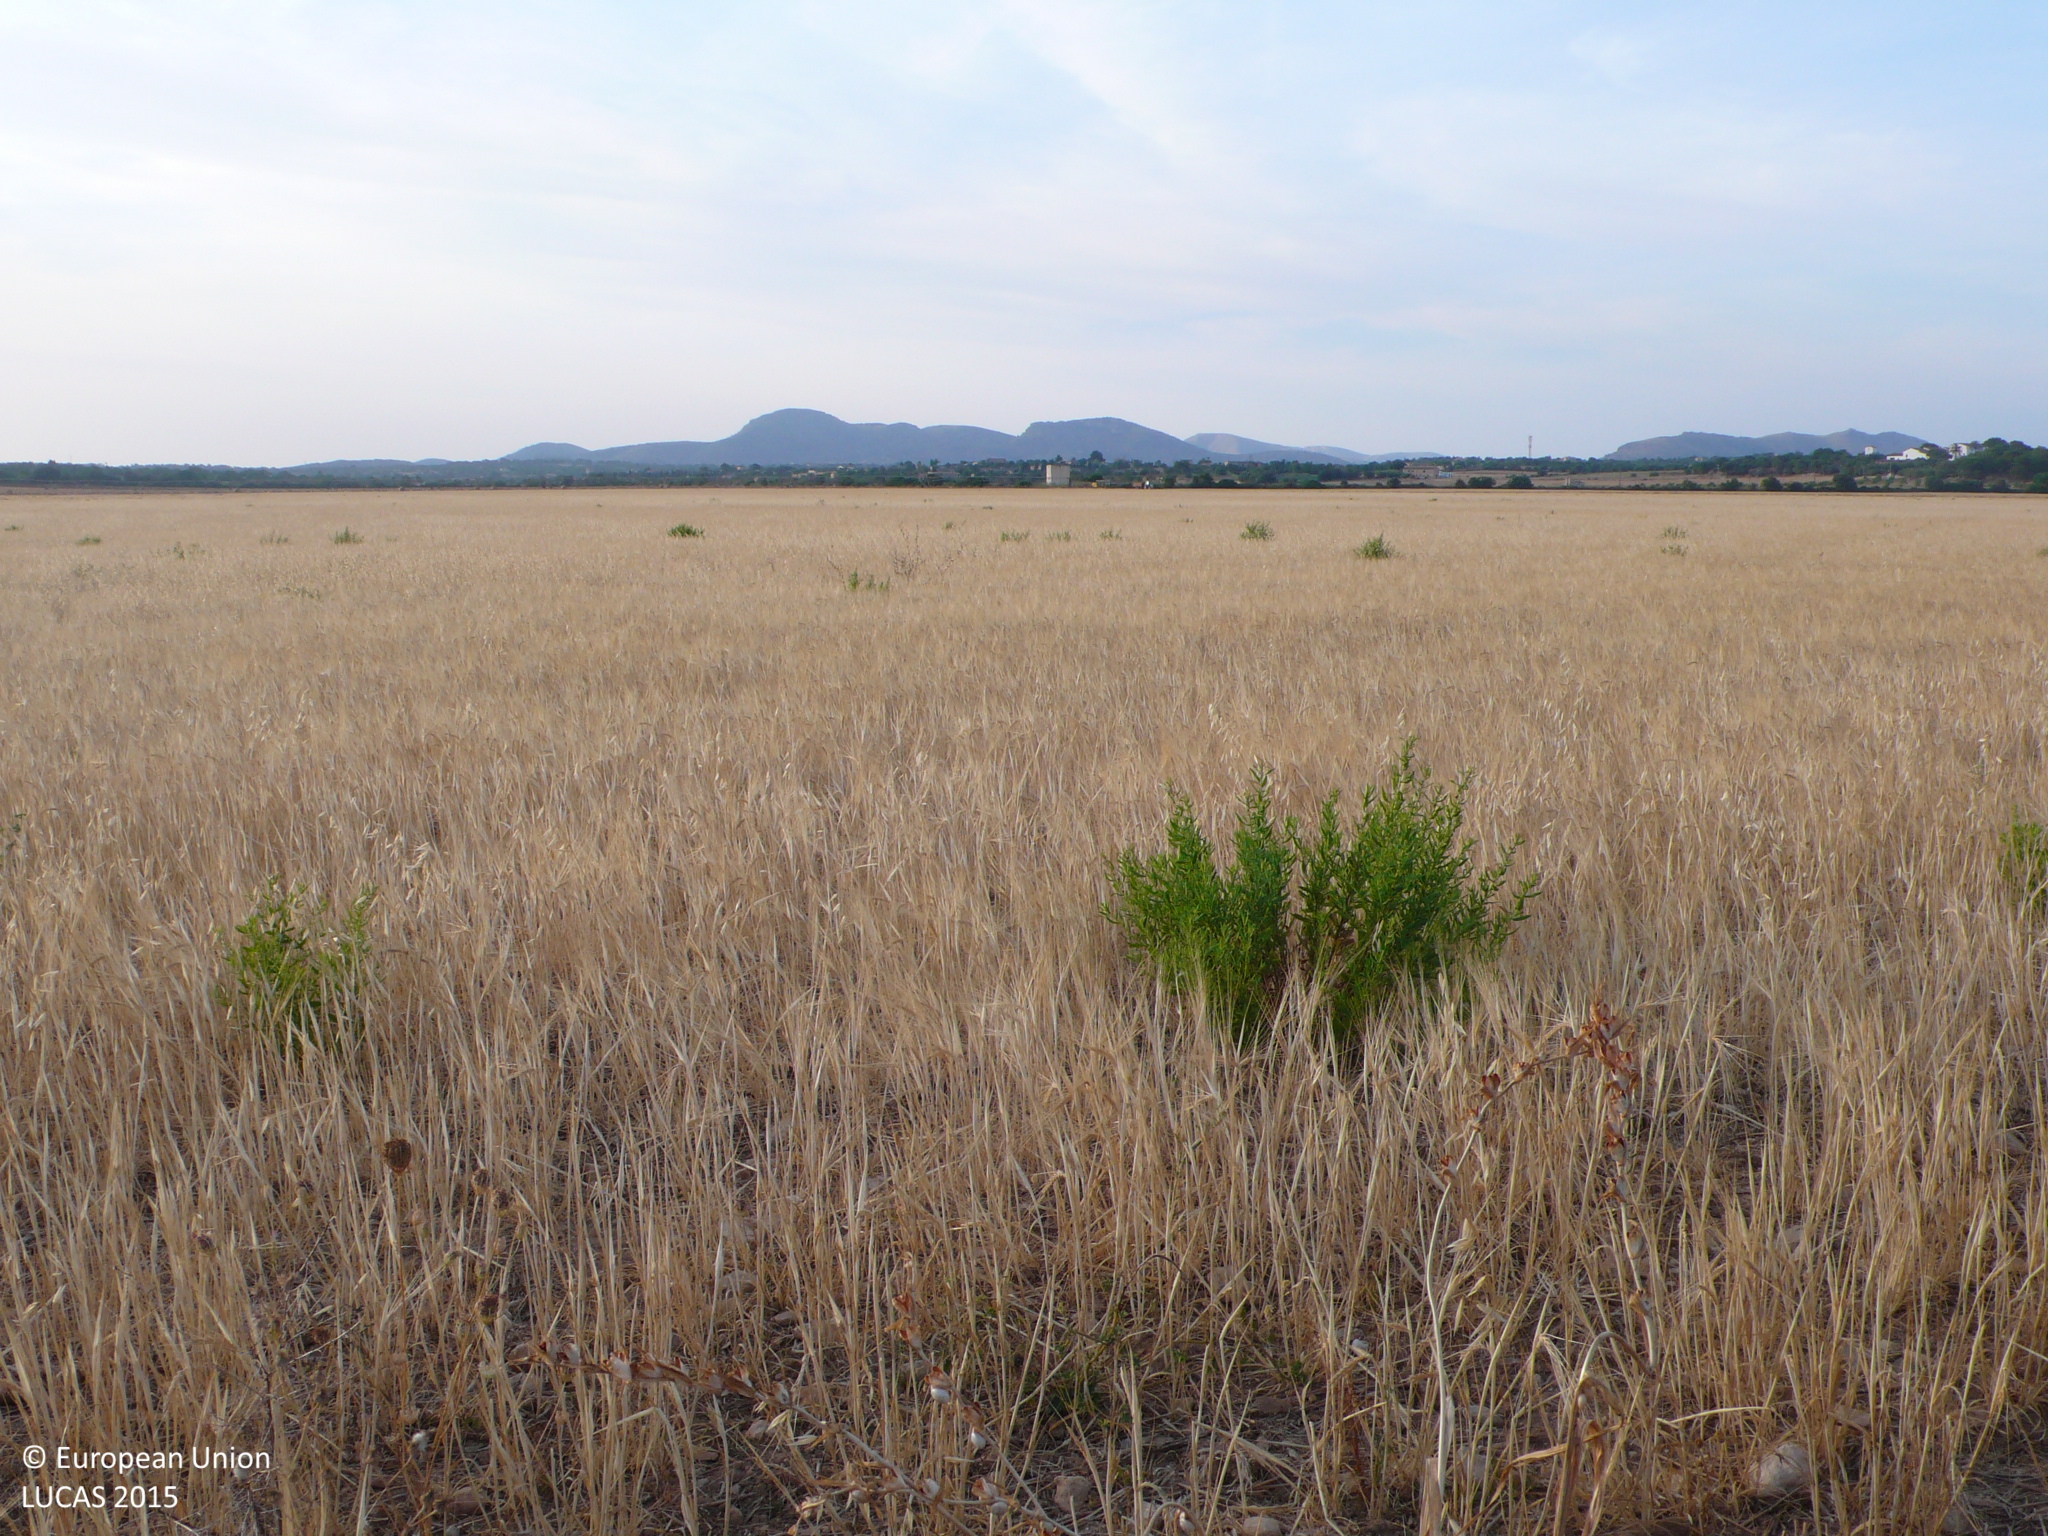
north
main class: Cropland
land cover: Mixed cereals for fodder
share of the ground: > 75 %
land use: Agriculture (excluding fallow land and kitchen gardens)
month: July
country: ES
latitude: 39.5637
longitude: 3.2673
